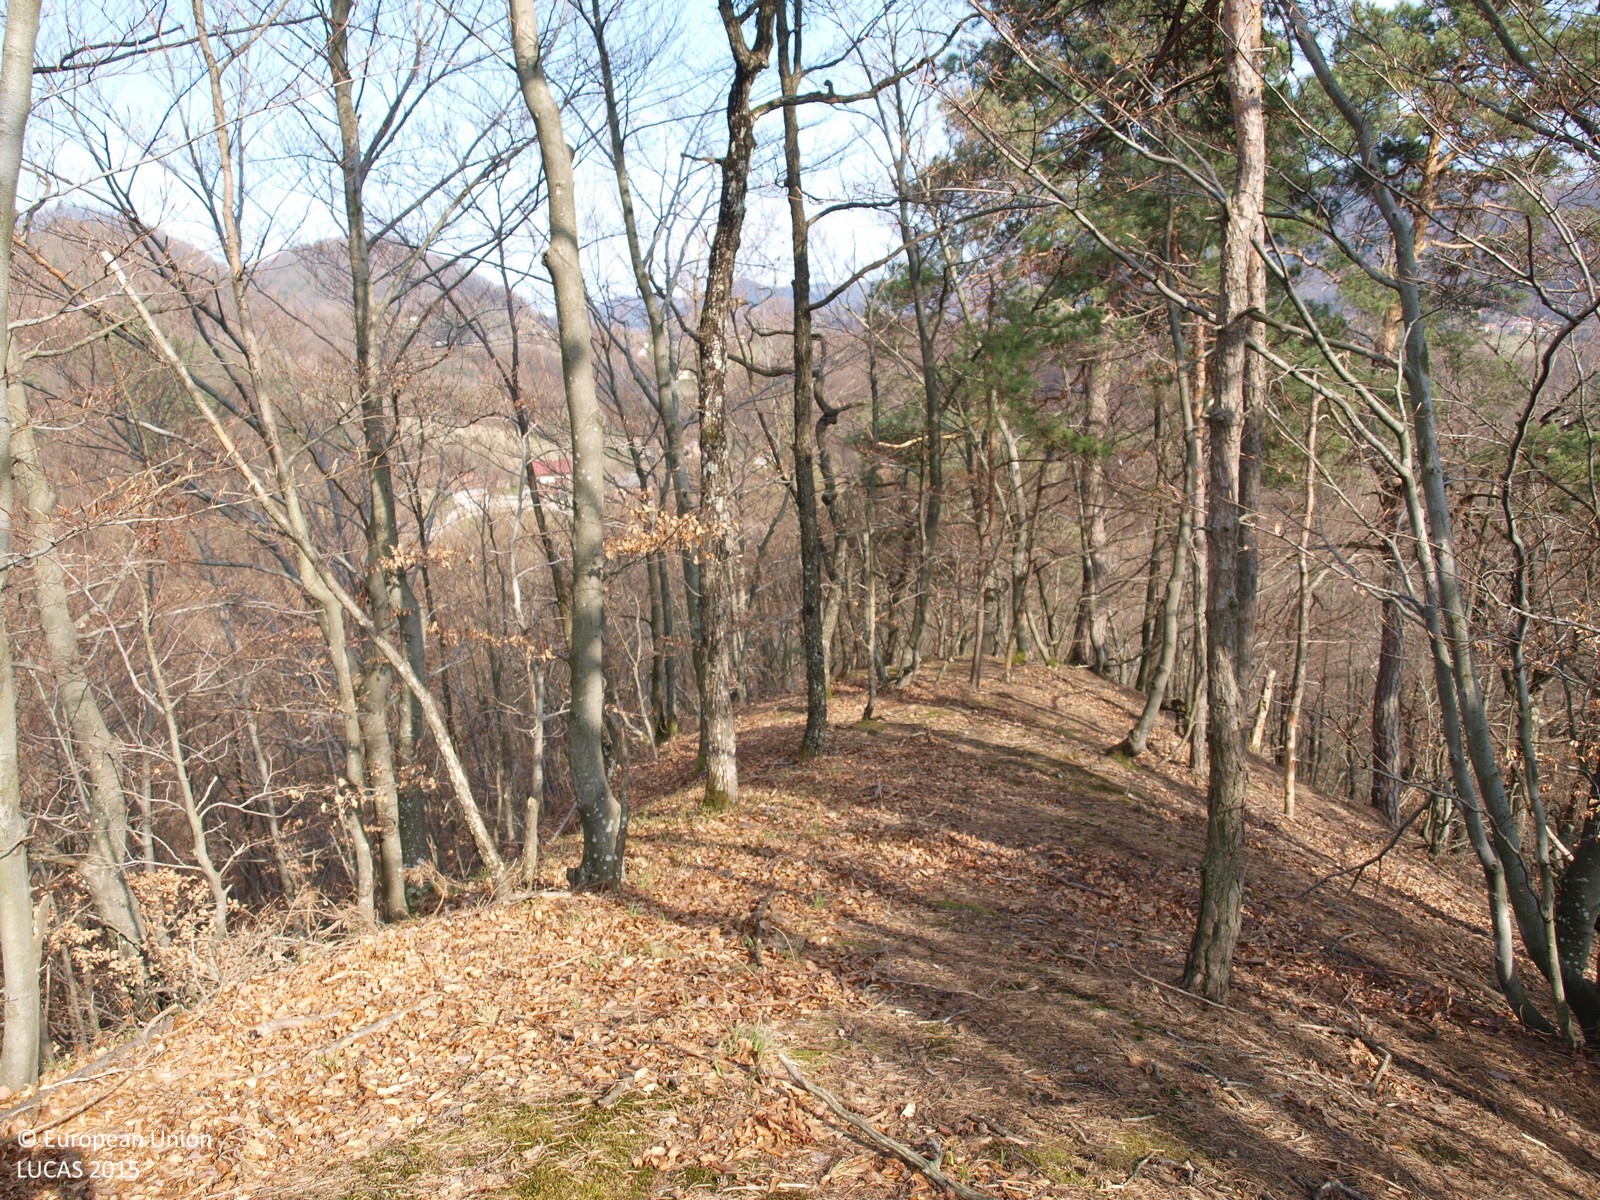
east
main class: Woodland
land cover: Broadleaved woodland
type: mesophytic deciduous forest
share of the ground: > 75 %
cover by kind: broadleaved forest trees 90 %, coniferous forest trees 10 %
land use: Forestry
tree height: > 5 m
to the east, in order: Broadleaved woodland; Tracks; Rivers and streams; Grassland without tree/shrub cover; Spontaneously vegetated surfaces
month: March
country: HR
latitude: 46.2935
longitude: 15.9575
